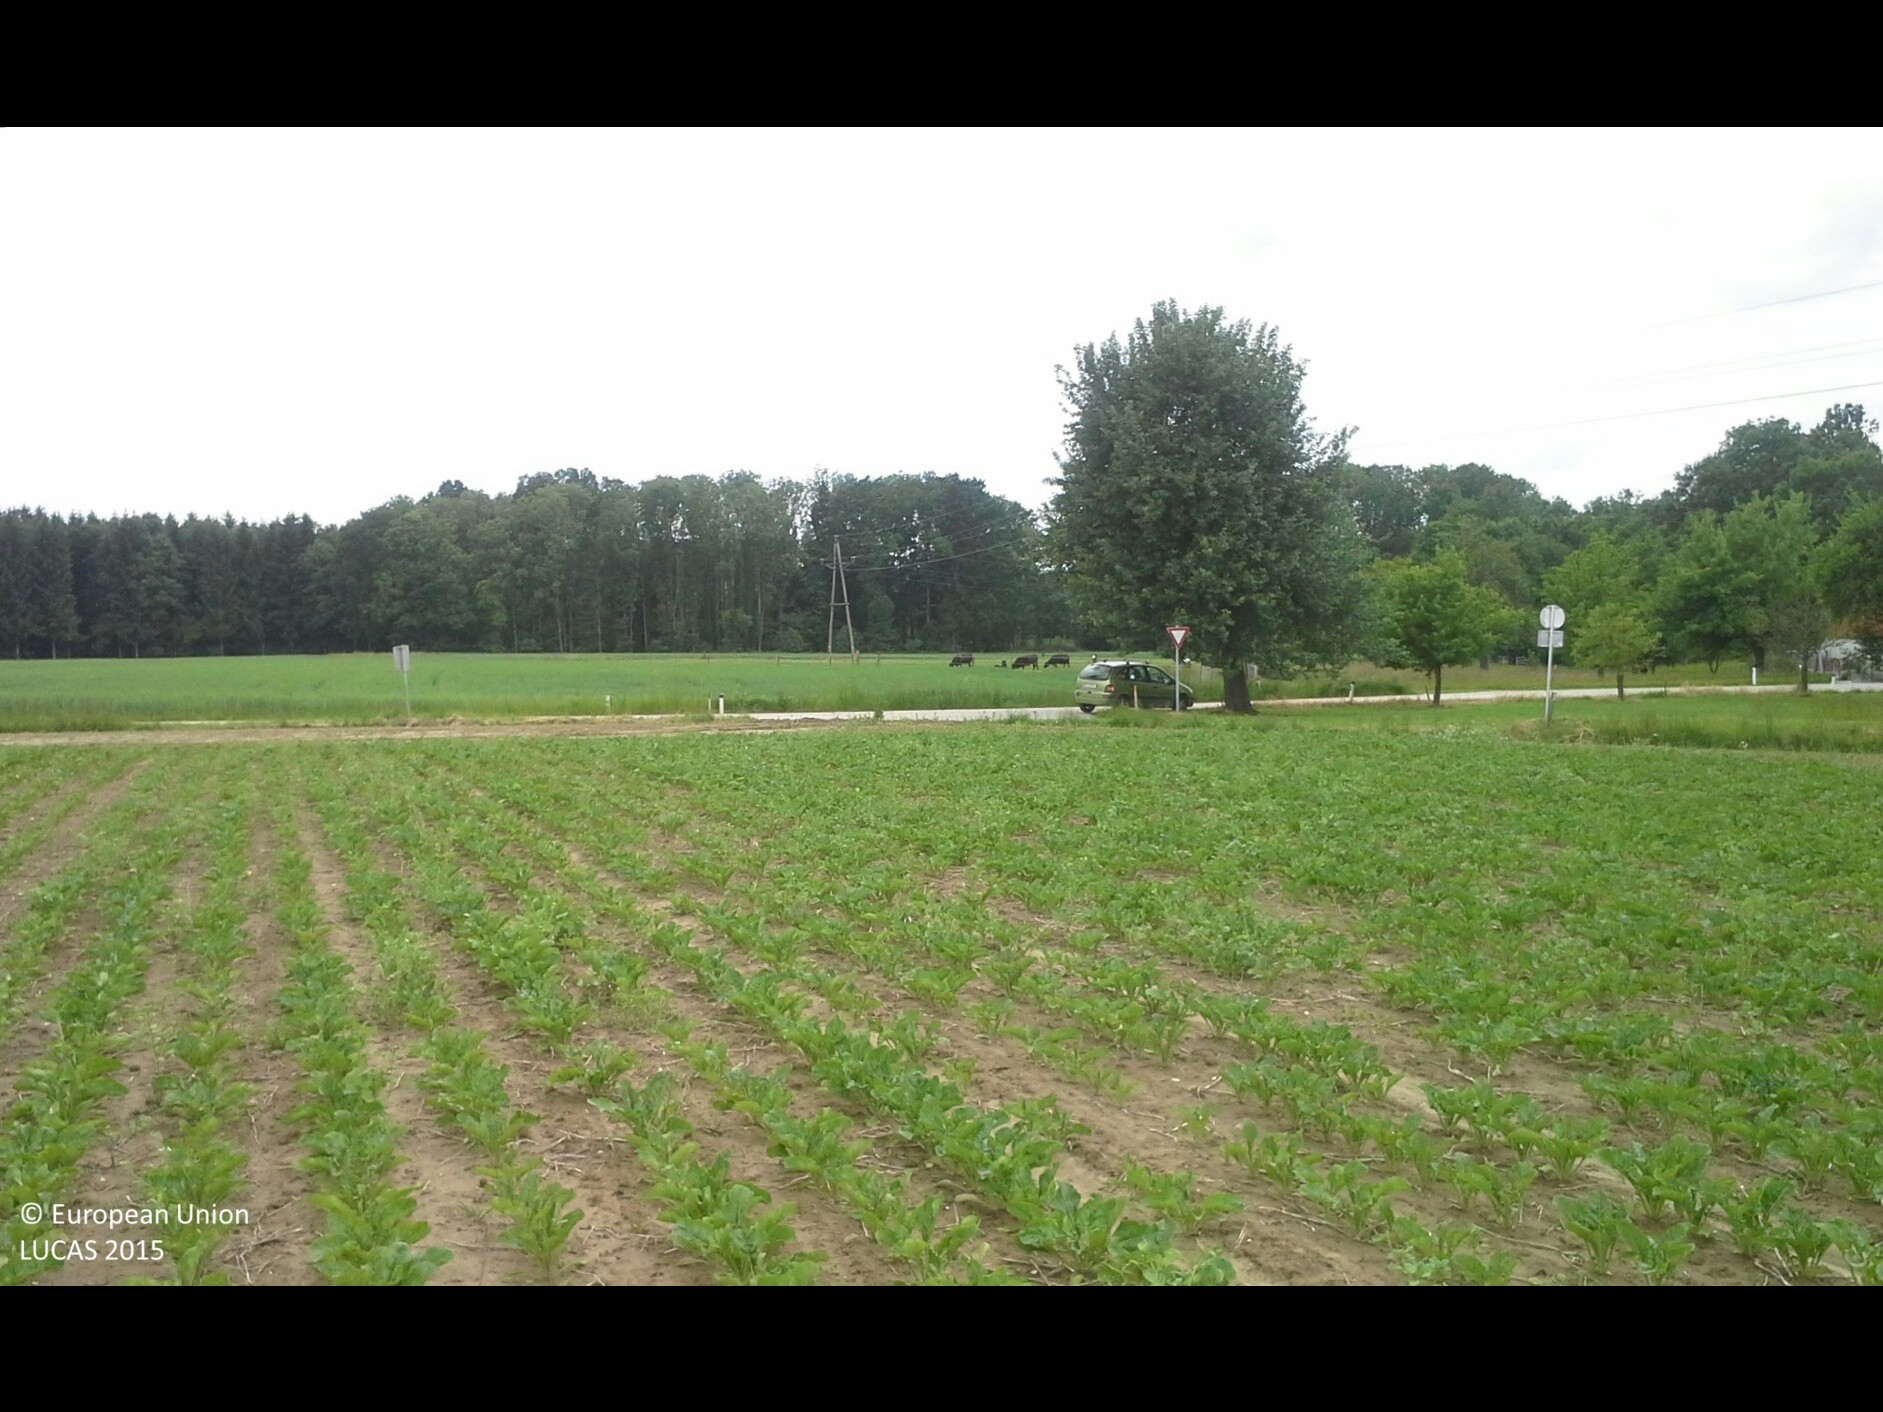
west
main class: Cropland
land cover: Sugar beet
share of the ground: 25 - 50 %
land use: Agriculture (excluding fallow land and kitchen gardens)
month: May
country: AT
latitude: 48.1170
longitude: 14.4195
